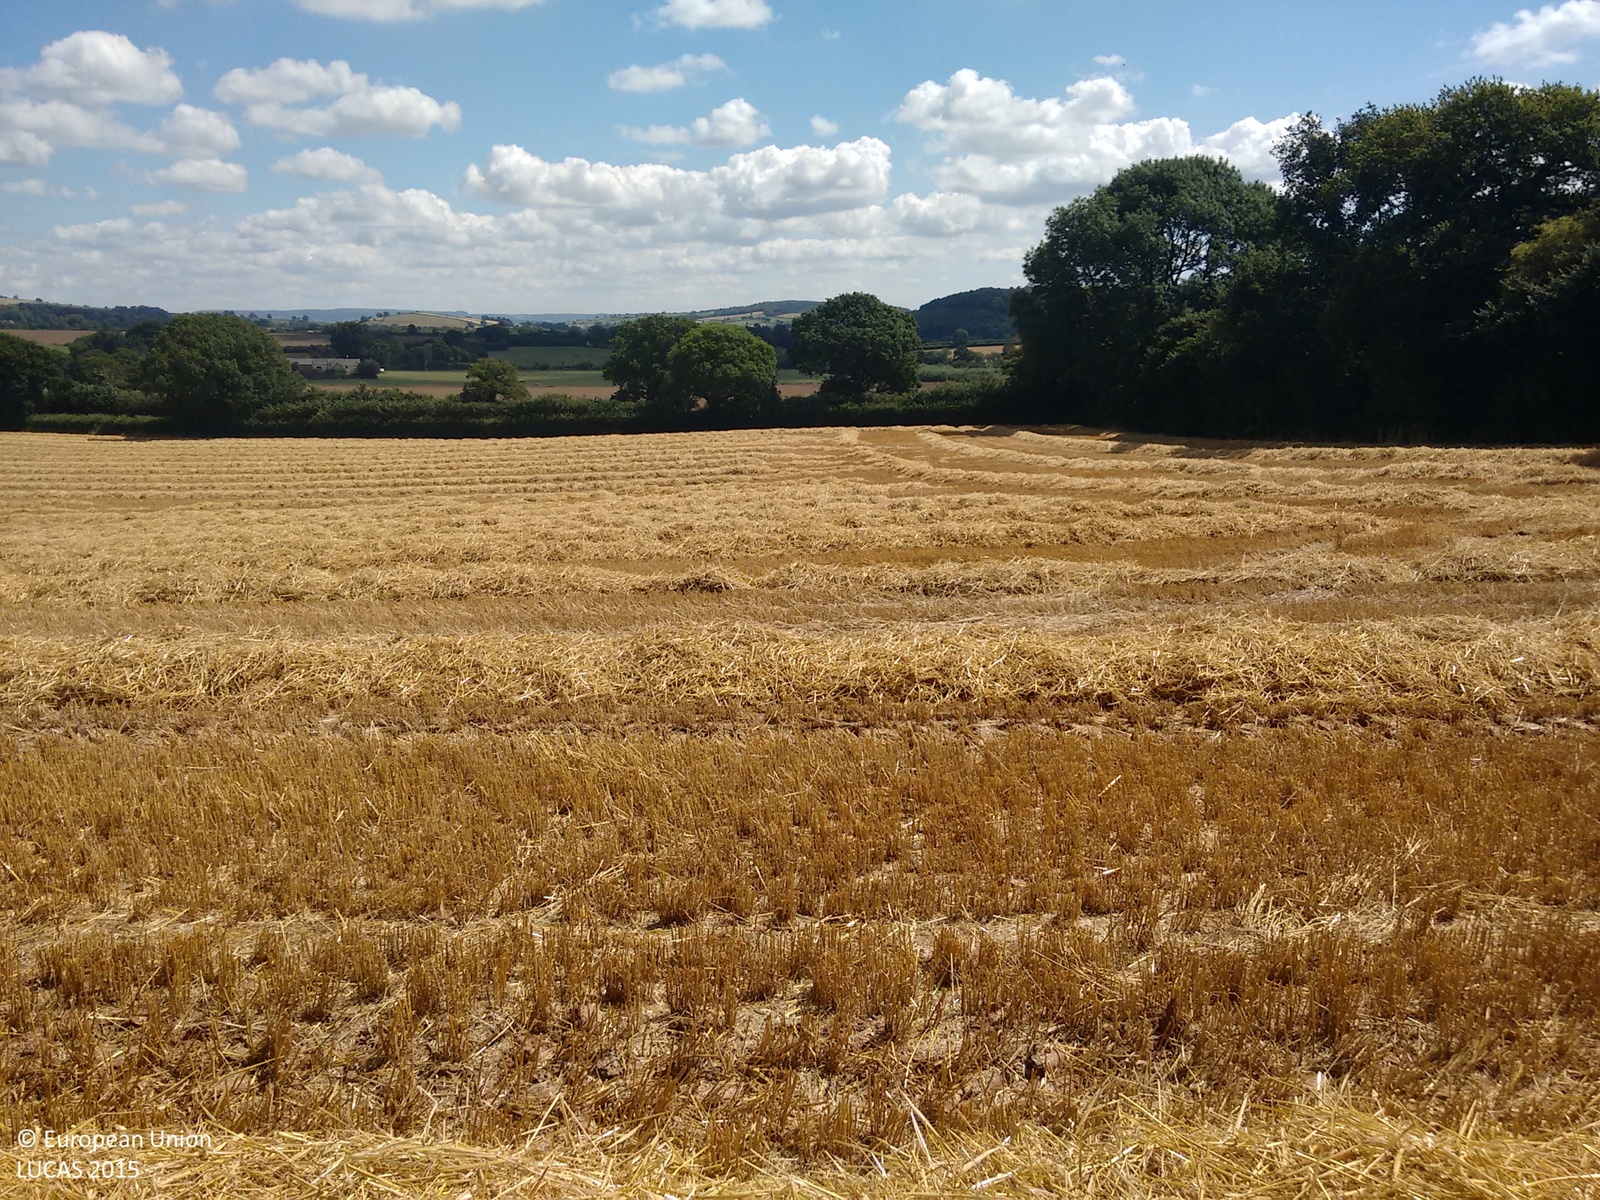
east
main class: Cropland
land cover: Barley
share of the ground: > 75 %
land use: Agriculture (excluding fallow land and kitchen gardens)
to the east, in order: Managed hedges; Grass margins; Barley; Grass margins; Managed hedges; Ditches and canals; Paved roads, cycling and walking lanes; Ditches and canals; Managed hedges; Rape and turnip rape
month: July
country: GB
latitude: 50.8001
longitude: -3.4921
